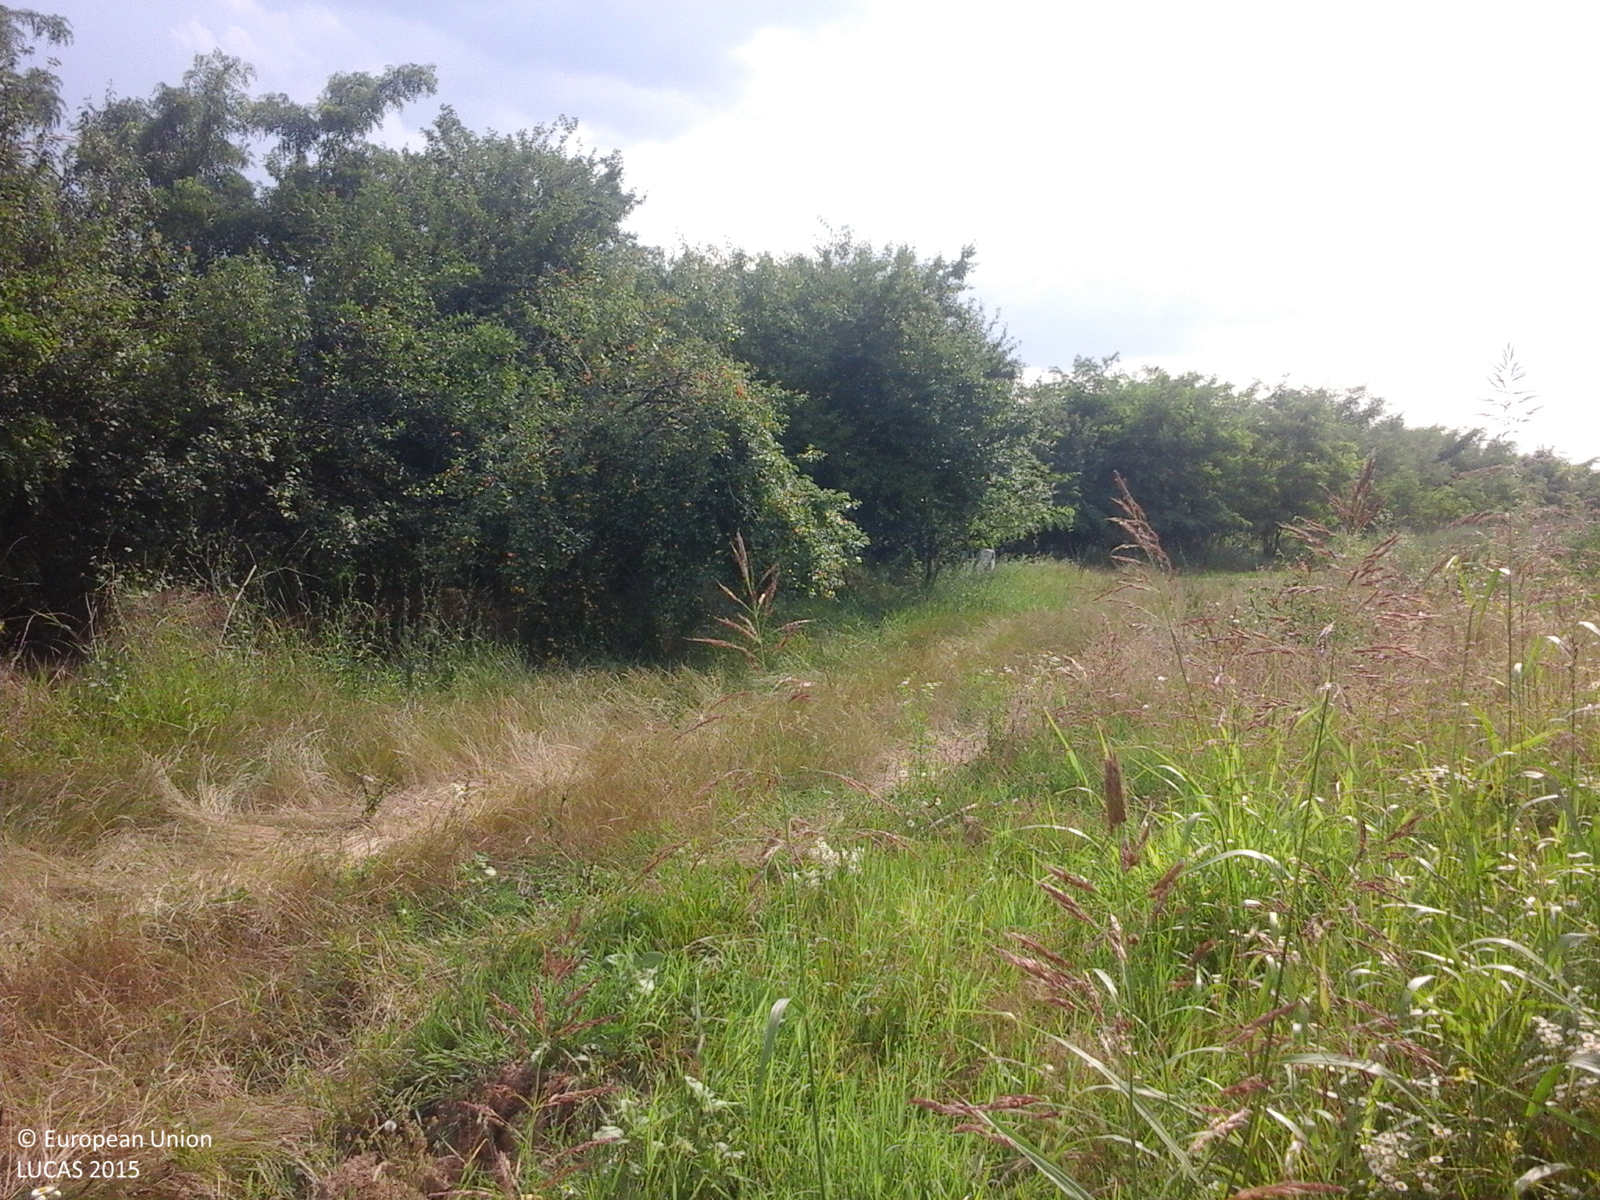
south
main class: Cropland
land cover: Maize
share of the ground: > 75 %
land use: Agriculture (excluding fallow land and kitchen gardens)
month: June
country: RO
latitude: 44.3171
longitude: 25.9609
